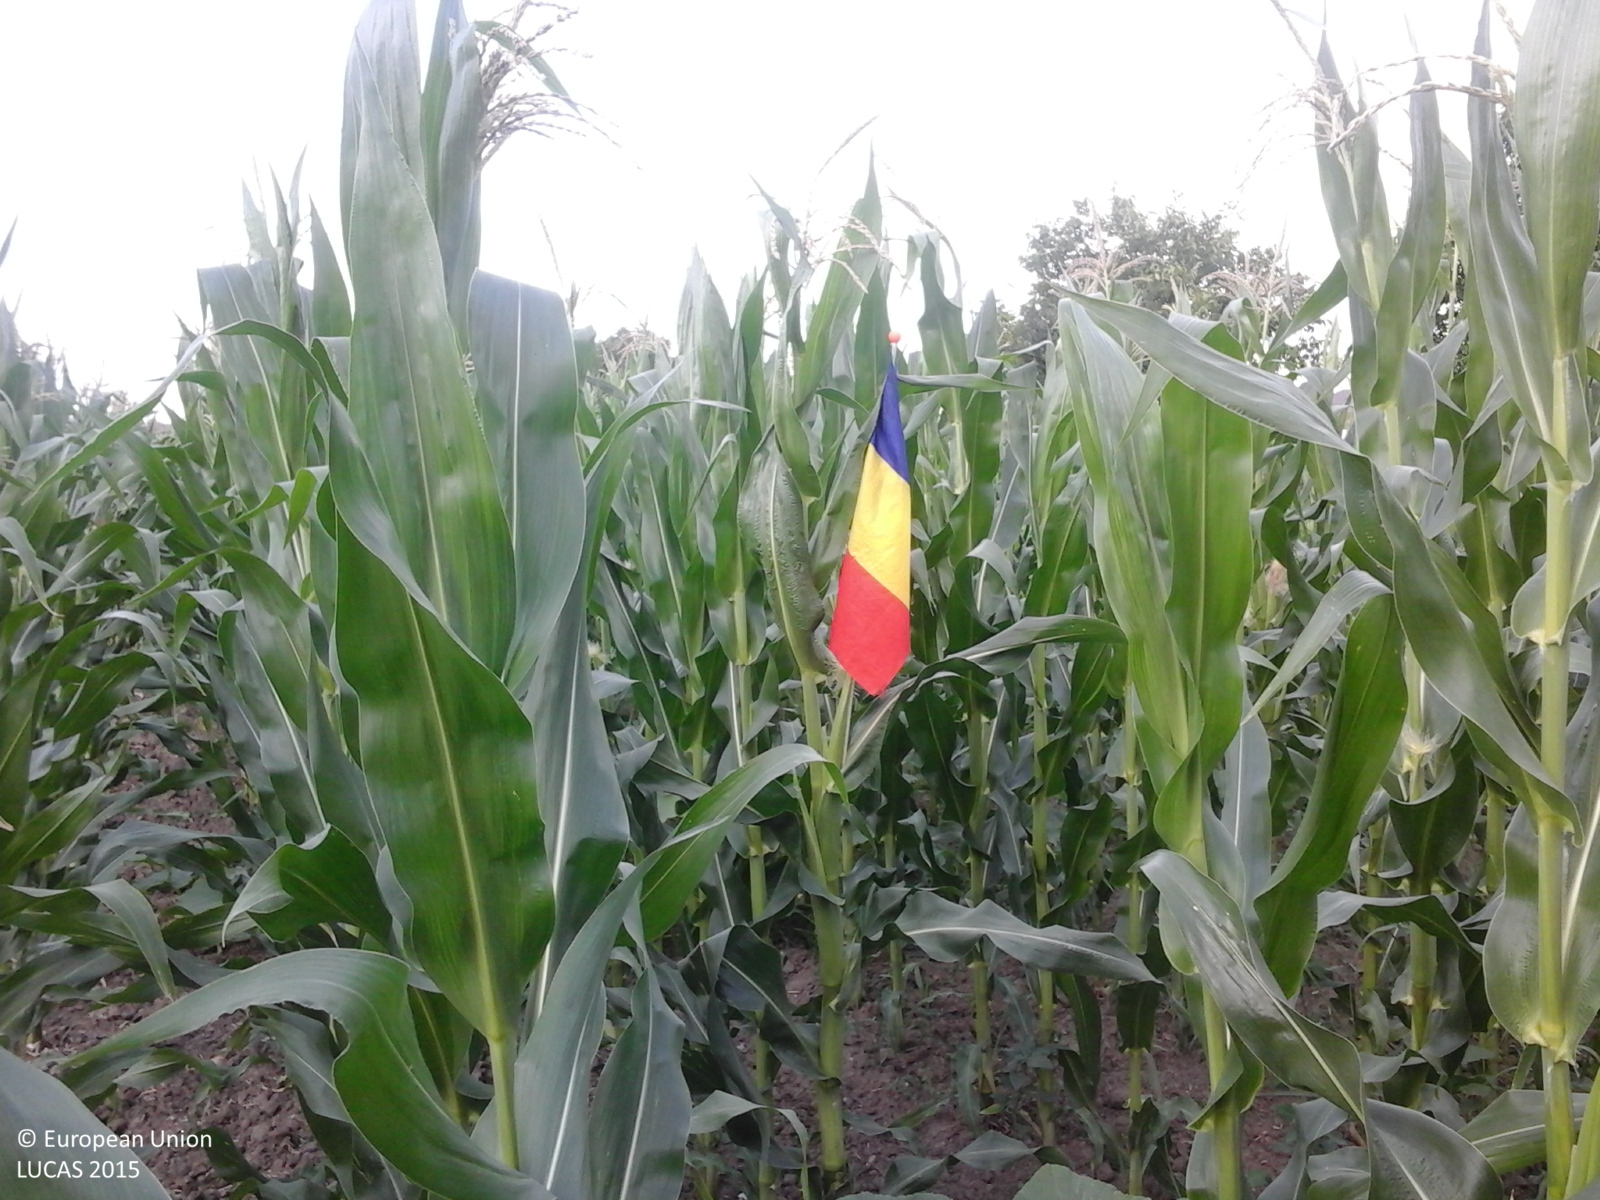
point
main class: Cropland
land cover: Maize
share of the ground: > 75 %
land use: Agriculture (excluding fallow land and kitchen gardens)
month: June
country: RO
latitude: 44.3175
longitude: 26.1923
